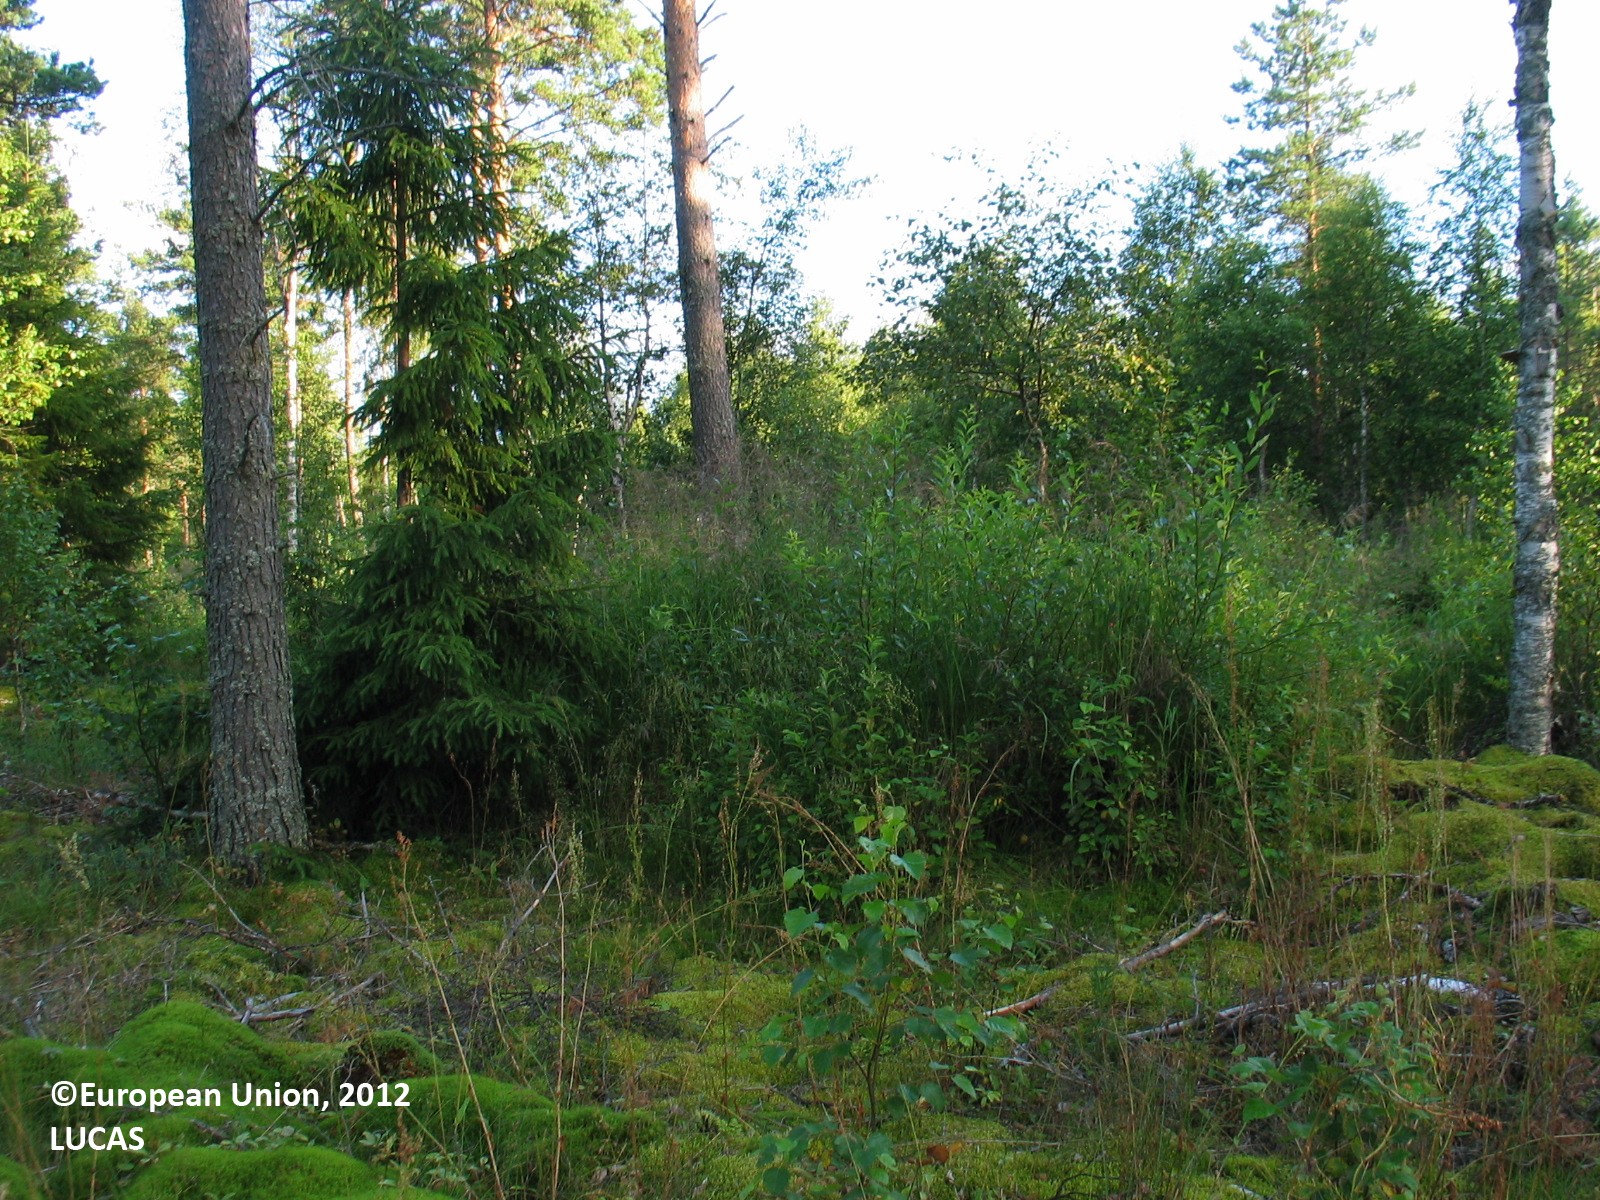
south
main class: Woodland
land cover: Other mixed woodland
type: boreal forest
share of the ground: 25 - 50 %
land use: Forestry
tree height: > 5 m
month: July
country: FI
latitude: 64.7034
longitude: 26.4067
